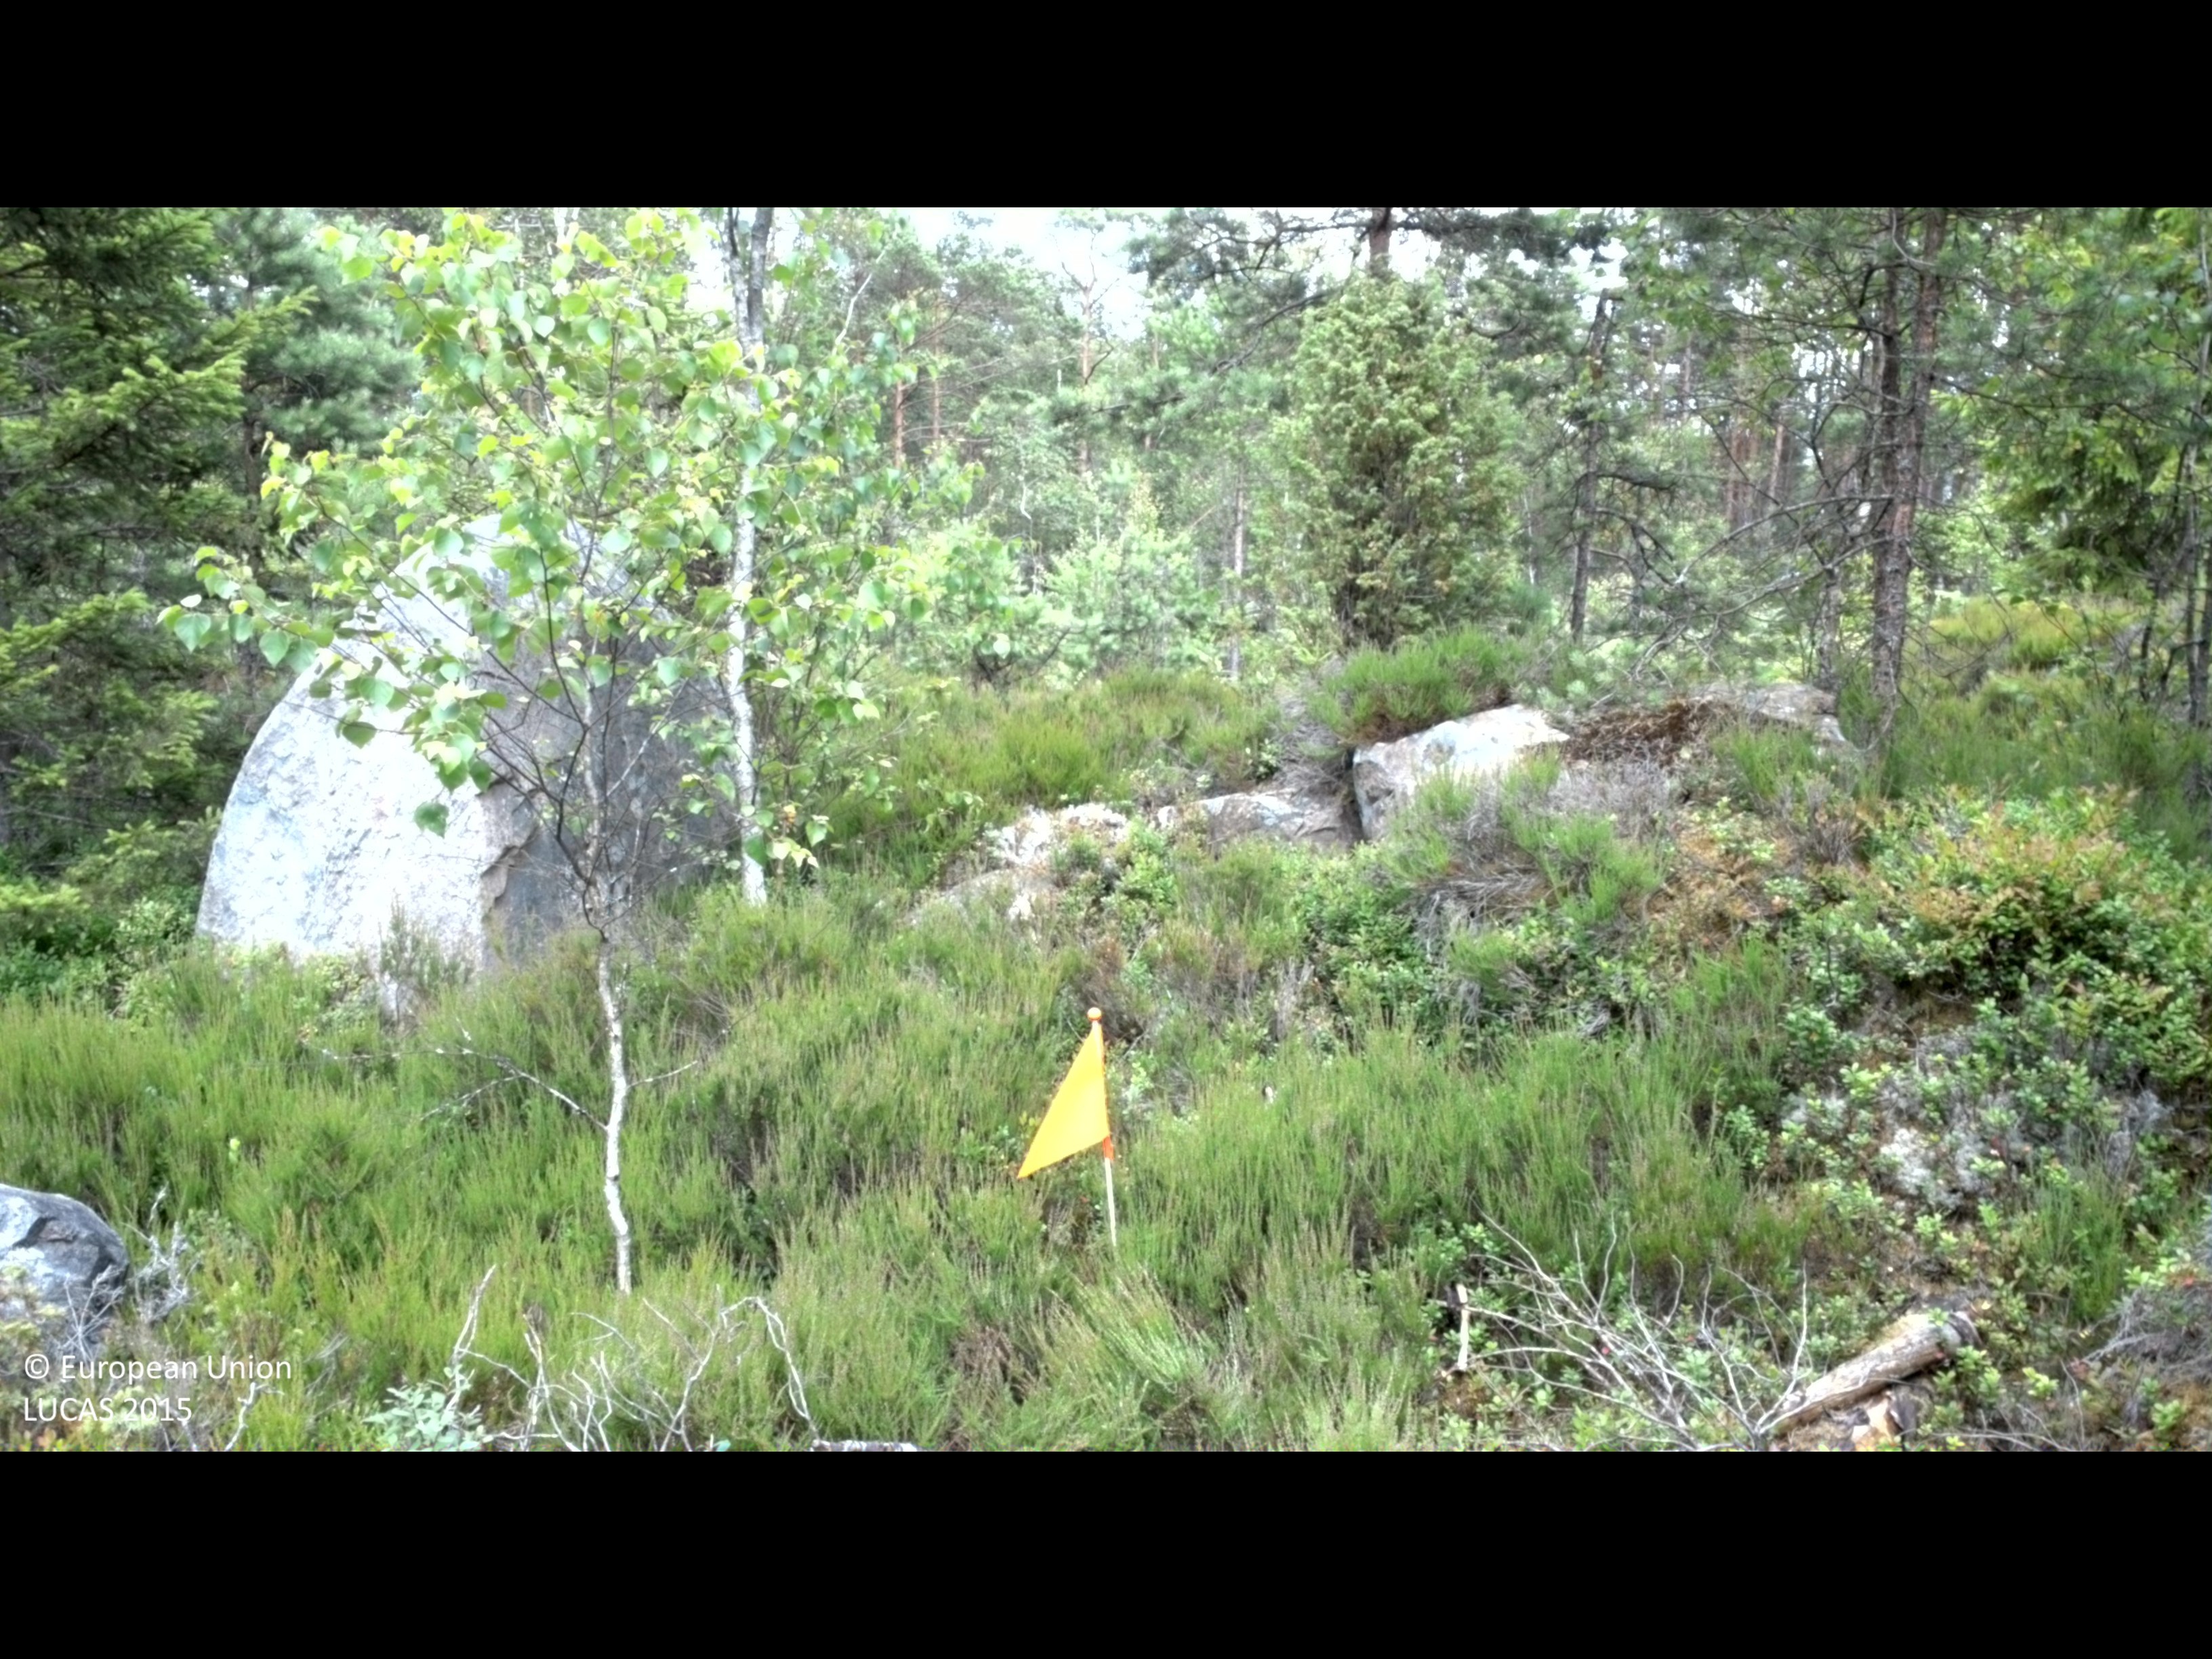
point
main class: Woodland
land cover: Pine dominated mixed woodland
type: boreal forest
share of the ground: 25 - 50 %
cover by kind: shrubs 35 %, coniferous forest trees 30 %, broadleaved forest trees 20 %, herbaceous plants 15 %
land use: Forestry
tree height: > 5 m
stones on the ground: 25 - 50 %
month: July
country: SE
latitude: 56.5289
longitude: 13.7525
